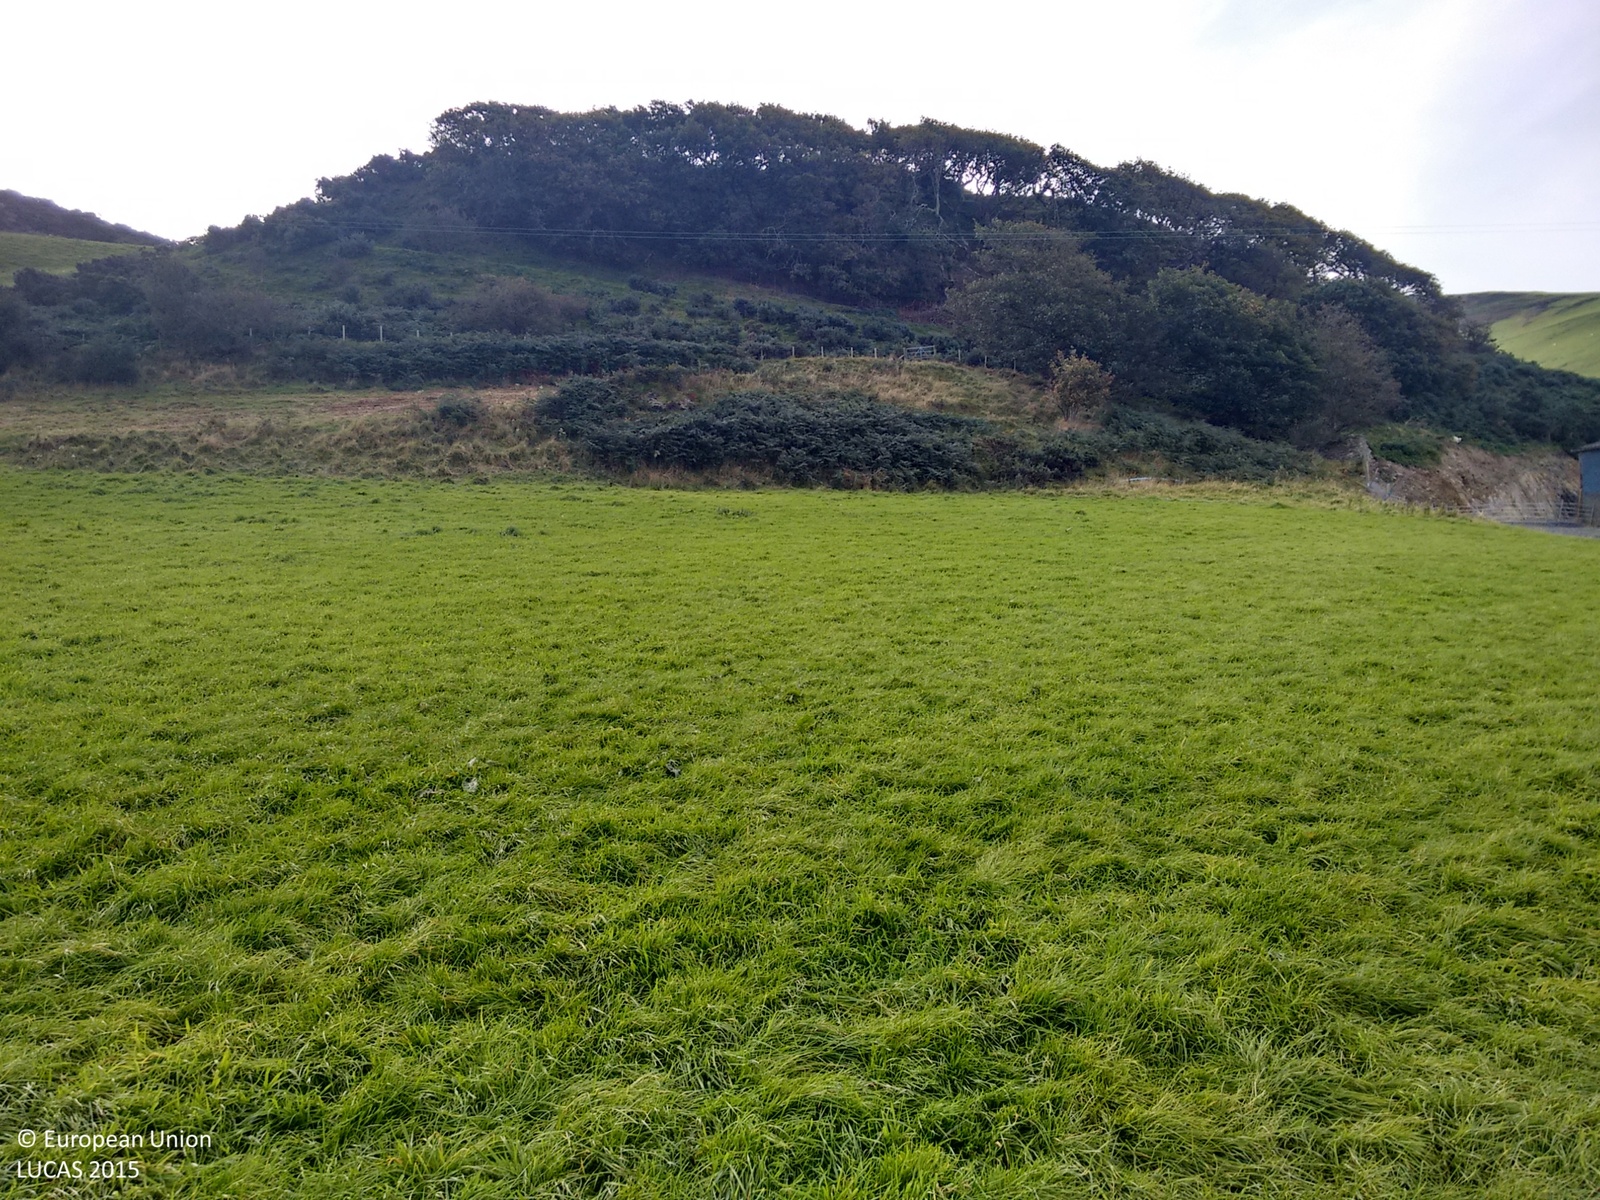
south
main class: Grassland
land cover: Grassland without tree/shrub cover
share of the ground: > 75 %
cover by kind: herbaceous plants 100 %
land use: Agriculture (excluding fallow land and kitchen gardens)
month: September
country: GB
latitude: 52.5959
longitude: -4.0465
